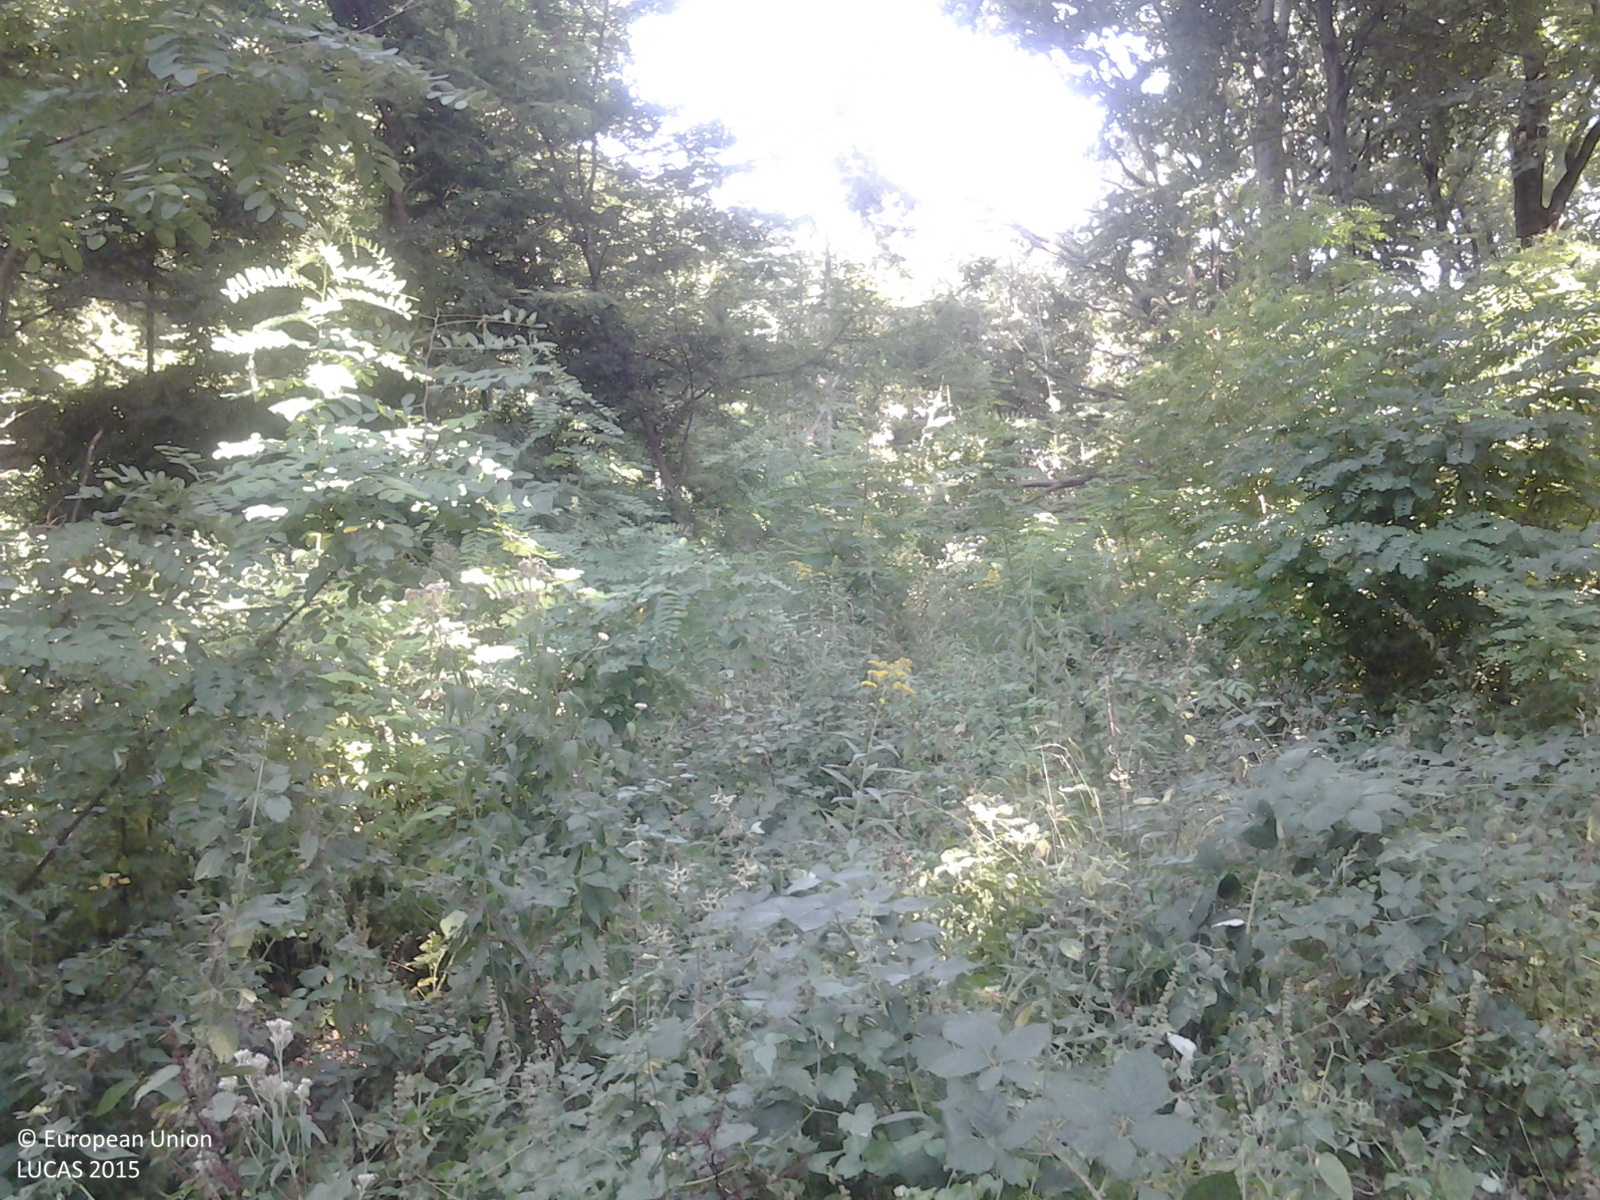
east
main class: Woodland
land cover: Broadleaved woodland
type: beech forest
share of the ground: > 75 %
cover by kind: broadleaved forest trees 90 %, herbaceous plants 10 %
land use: Forestry
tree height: > 5 m
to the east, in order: Broadleaved woodland; Maize
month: August
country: HU
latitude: 46.5338
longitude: 17.0569
